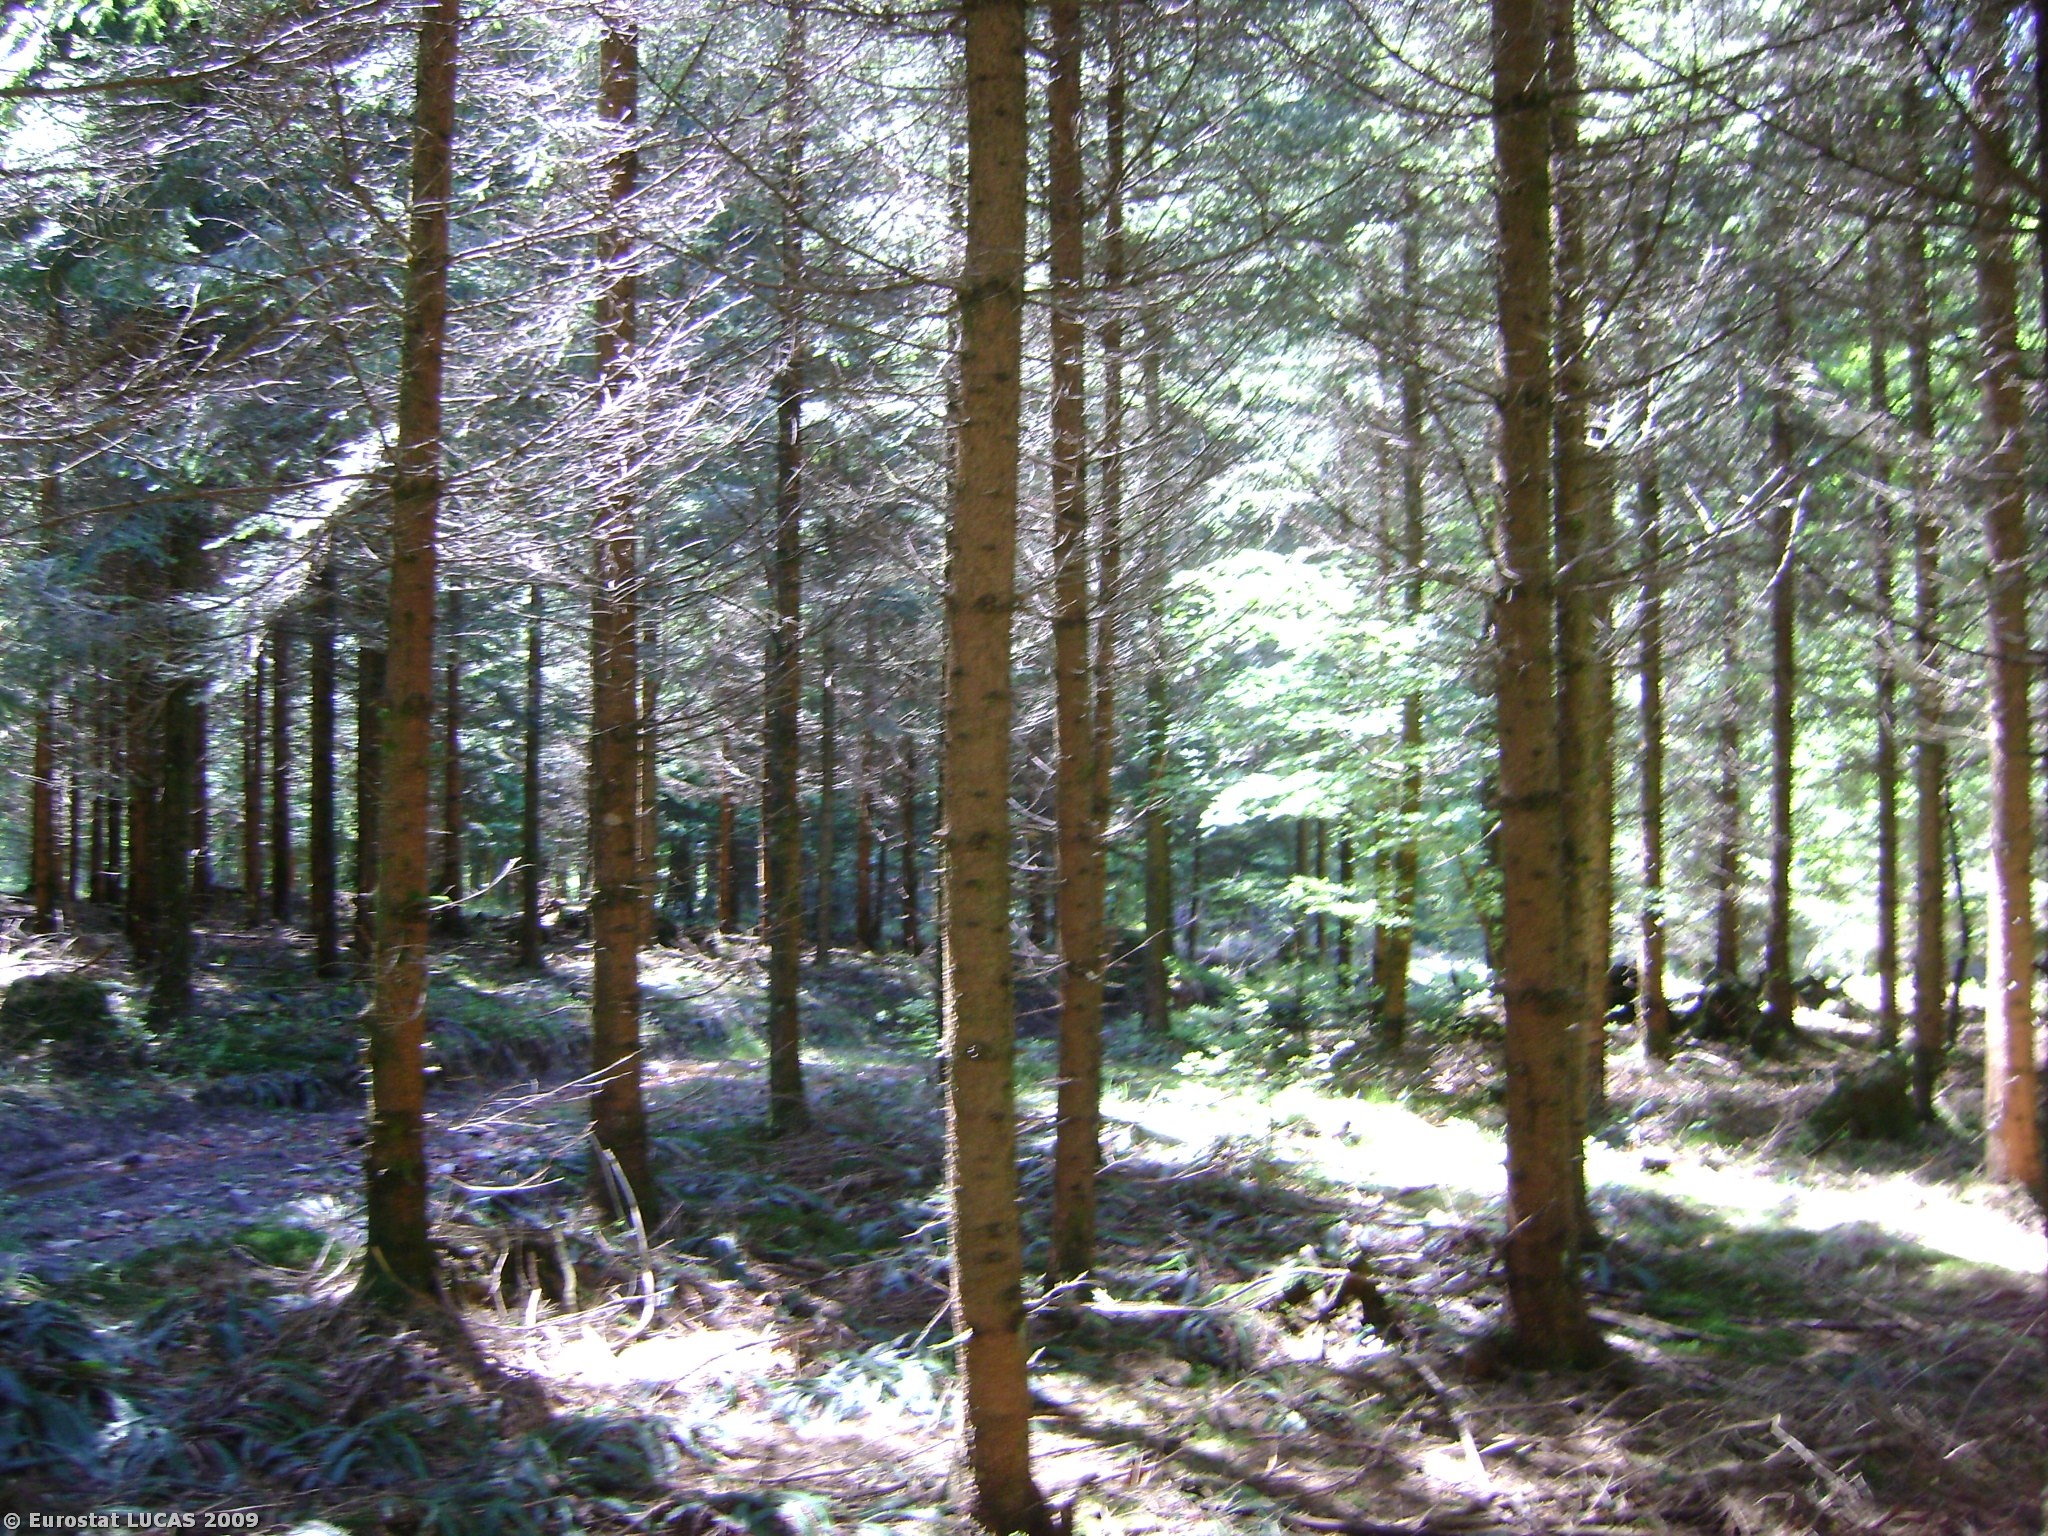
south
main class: Woodland
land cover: Coniferous woodland
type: hemiboreal forest and nemoral coniferous forest and mixed broadleaved-coniferous forest
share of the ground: > 75 %
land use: Forestry
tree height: > 5 m
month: May
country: AT
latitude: 47.8516
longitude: 13.2463
